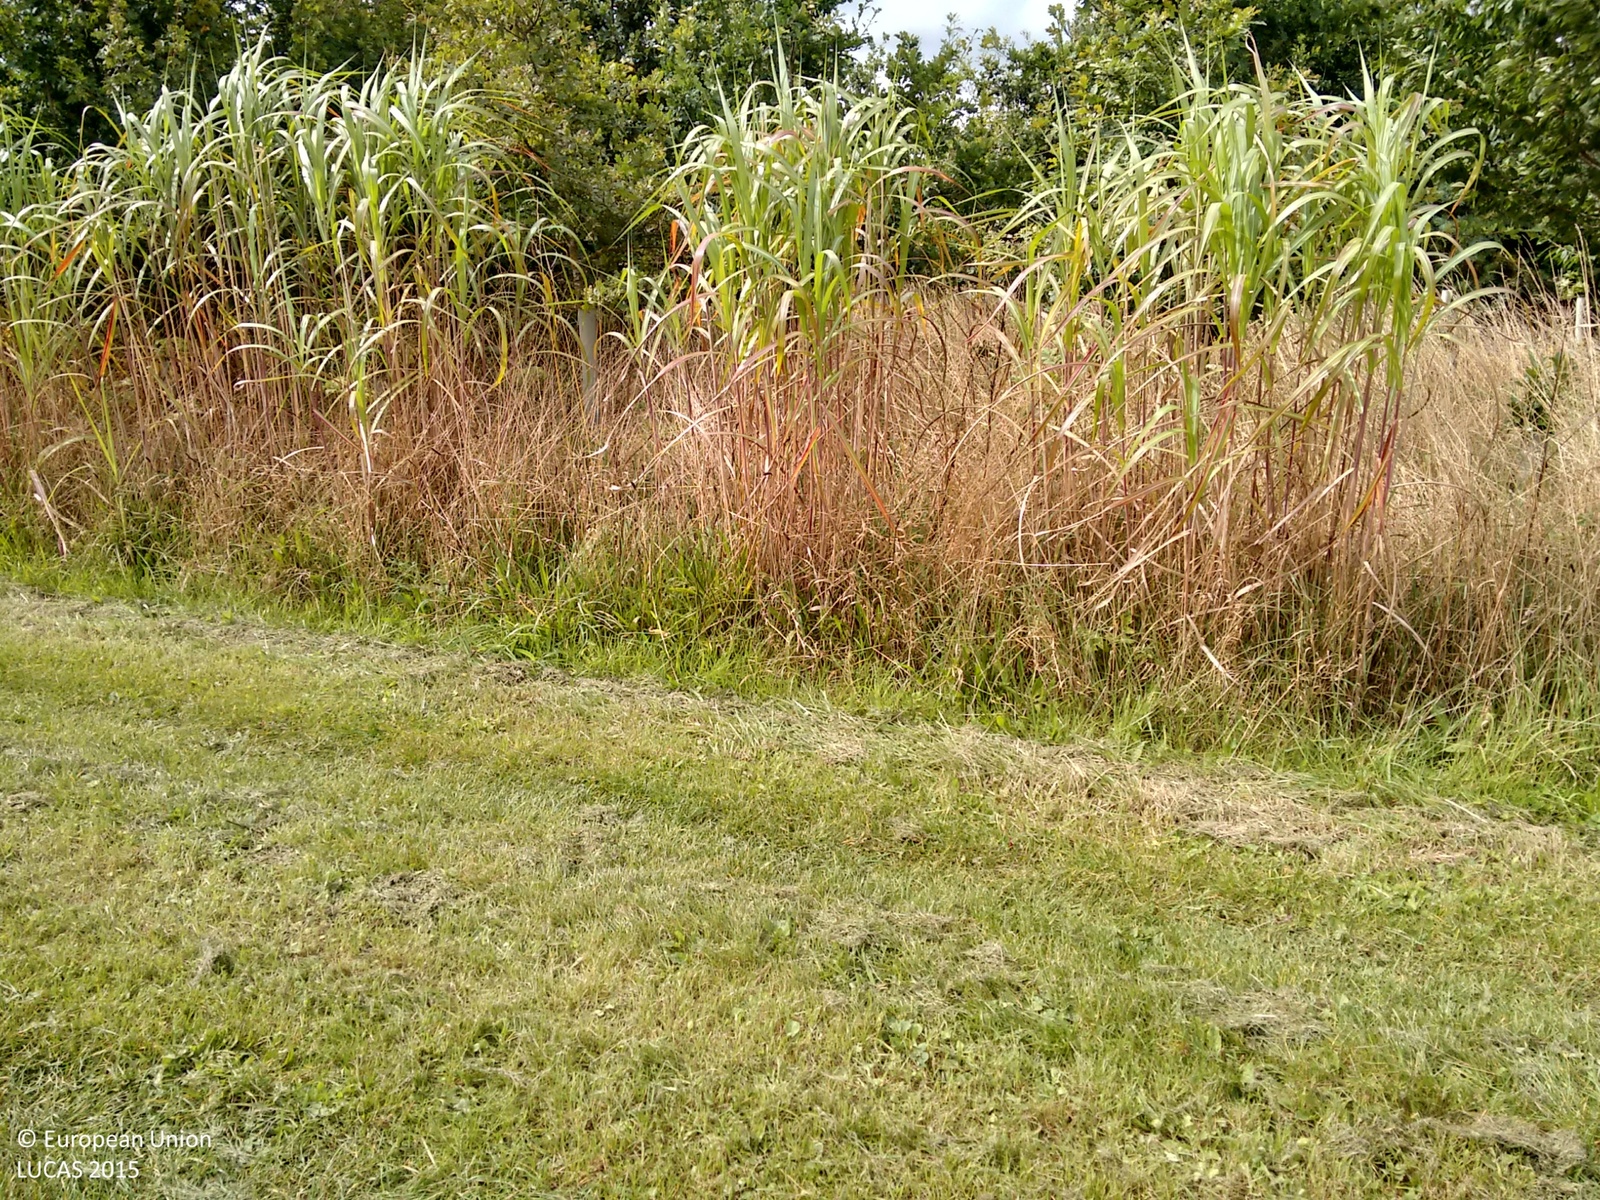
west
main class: Cropland
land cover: Common wheat
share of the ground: > 75 %
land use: Agriculture (excluding fallow land and kitchen gardens)
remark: Harvested field
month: September
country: GB
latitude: 52.6170
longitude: 0.8031
